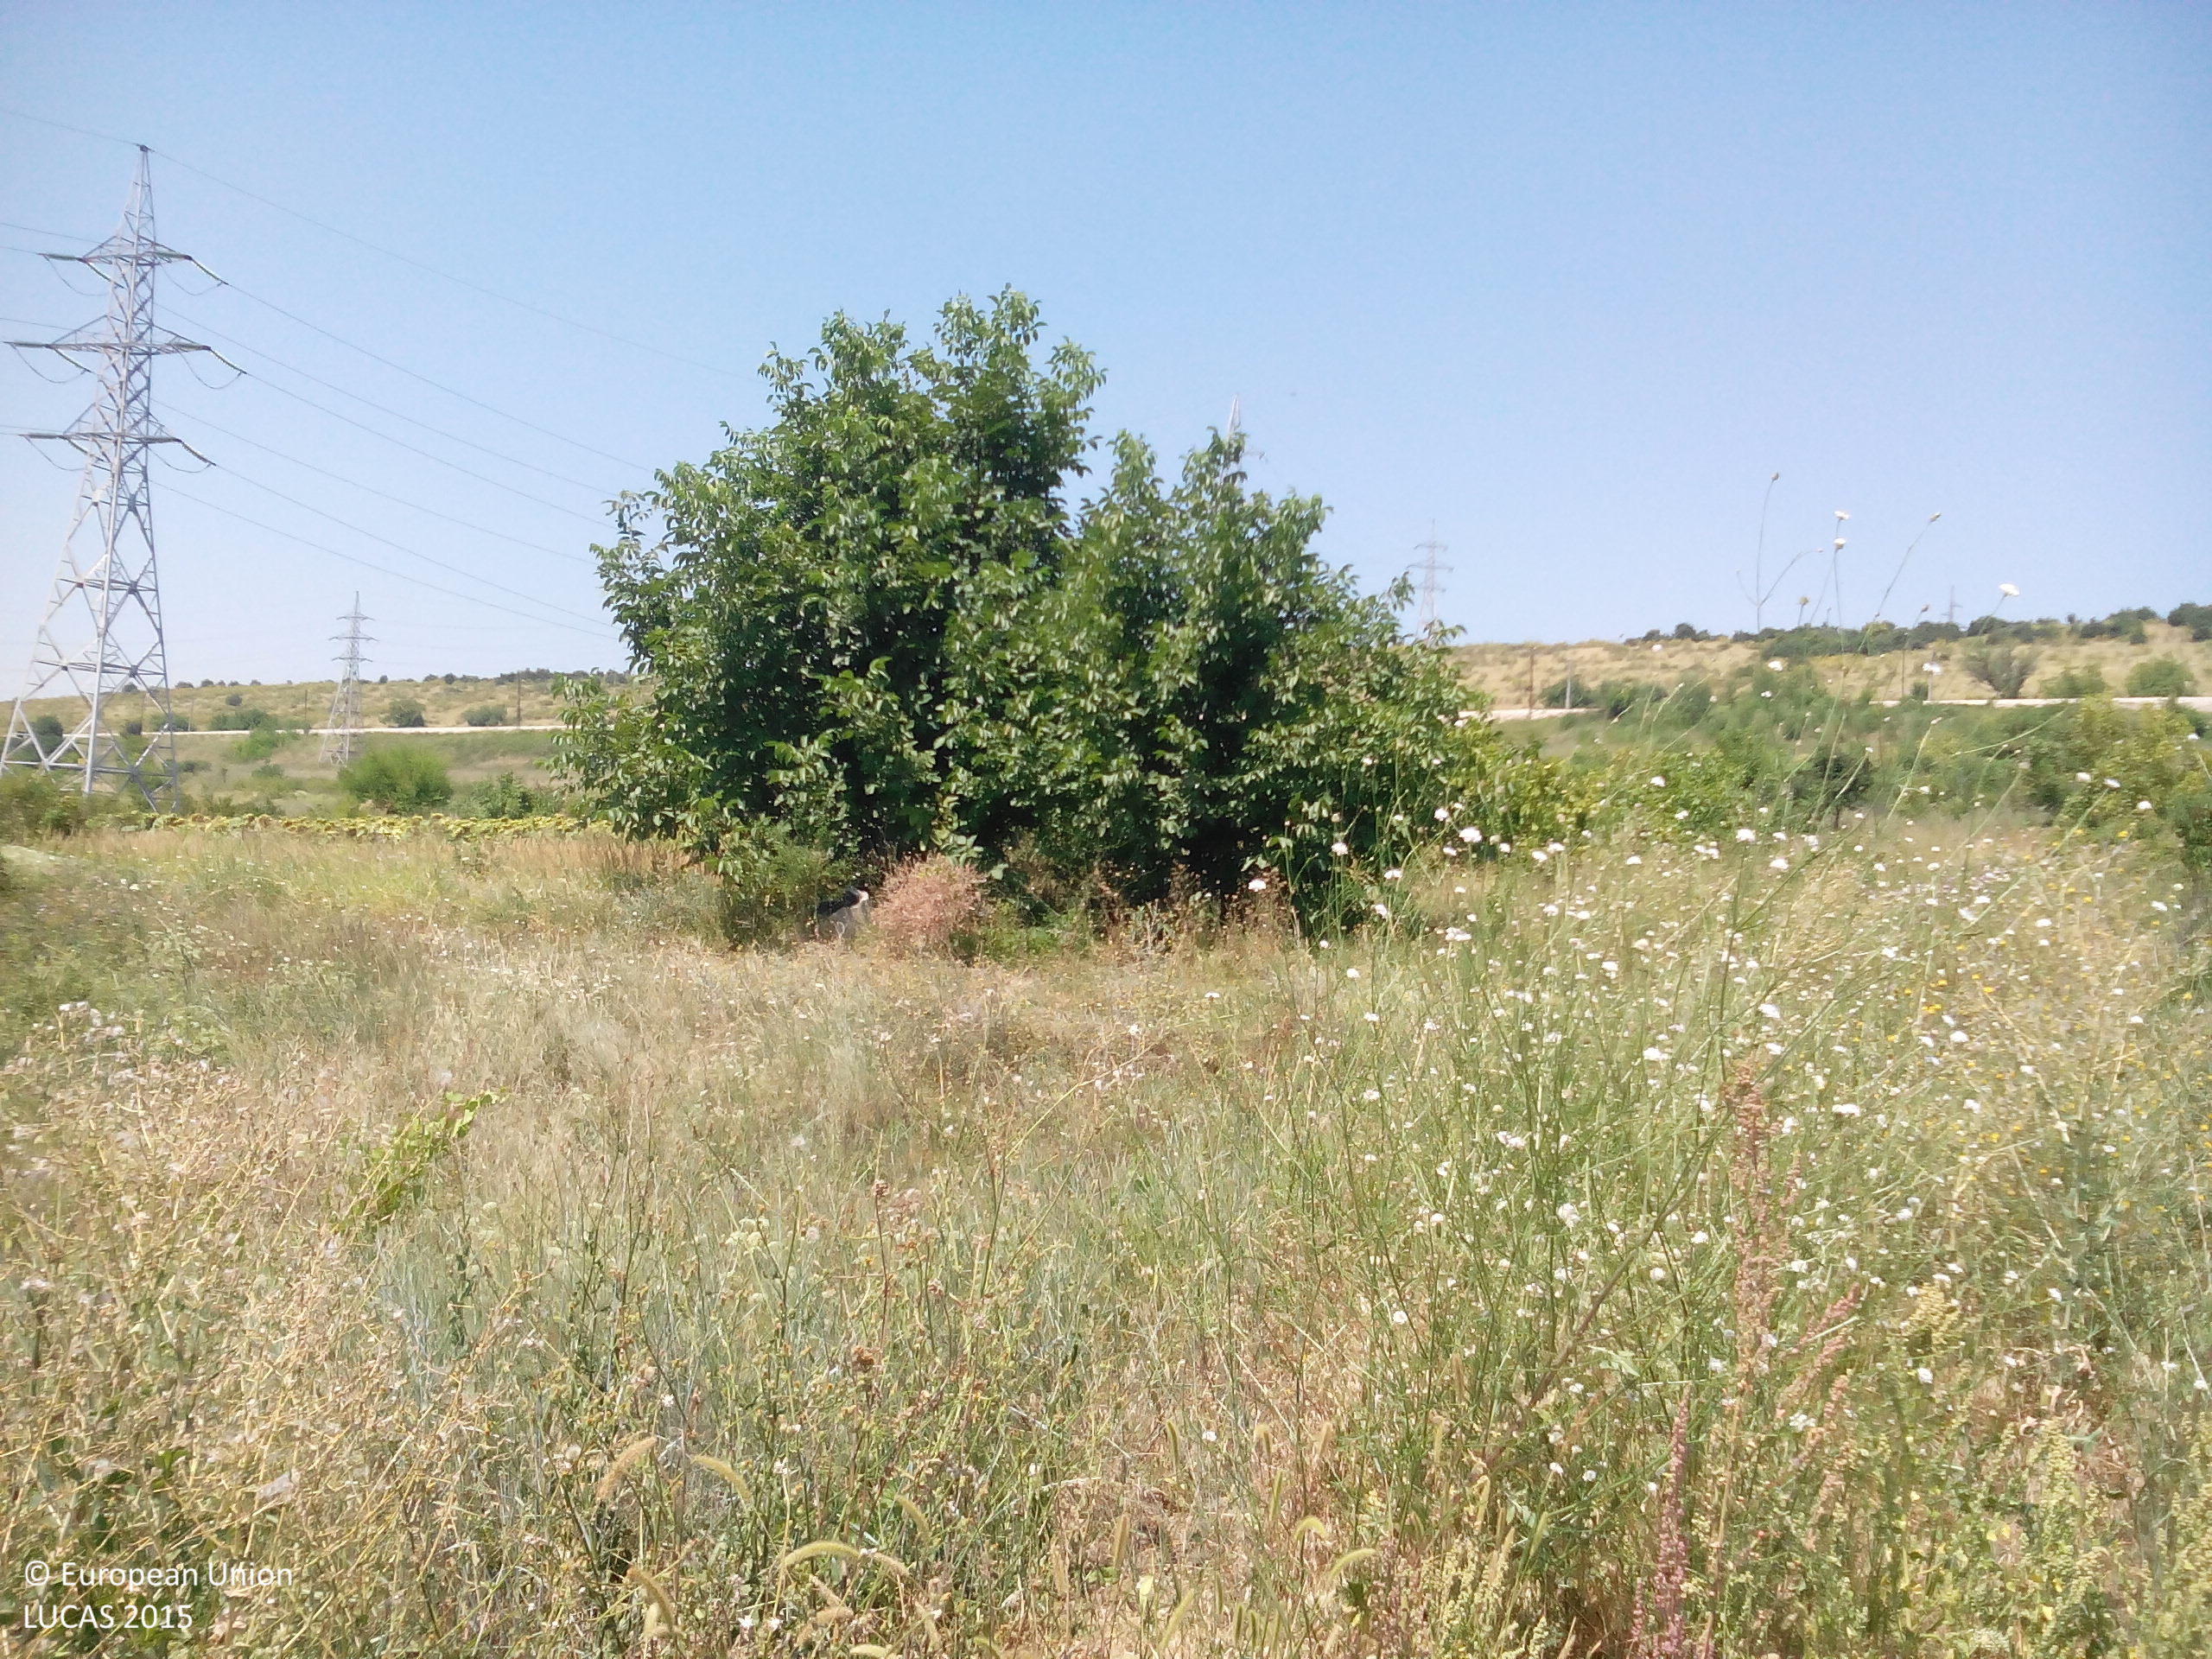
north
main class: Cropland
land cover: Dry pulses
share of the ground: 25 - 50 %
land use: Agriculture (excluding fallow land and kitchen gardens)
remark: Harvested field
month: July
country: BG
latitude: 43.2819
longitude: 24.1635
